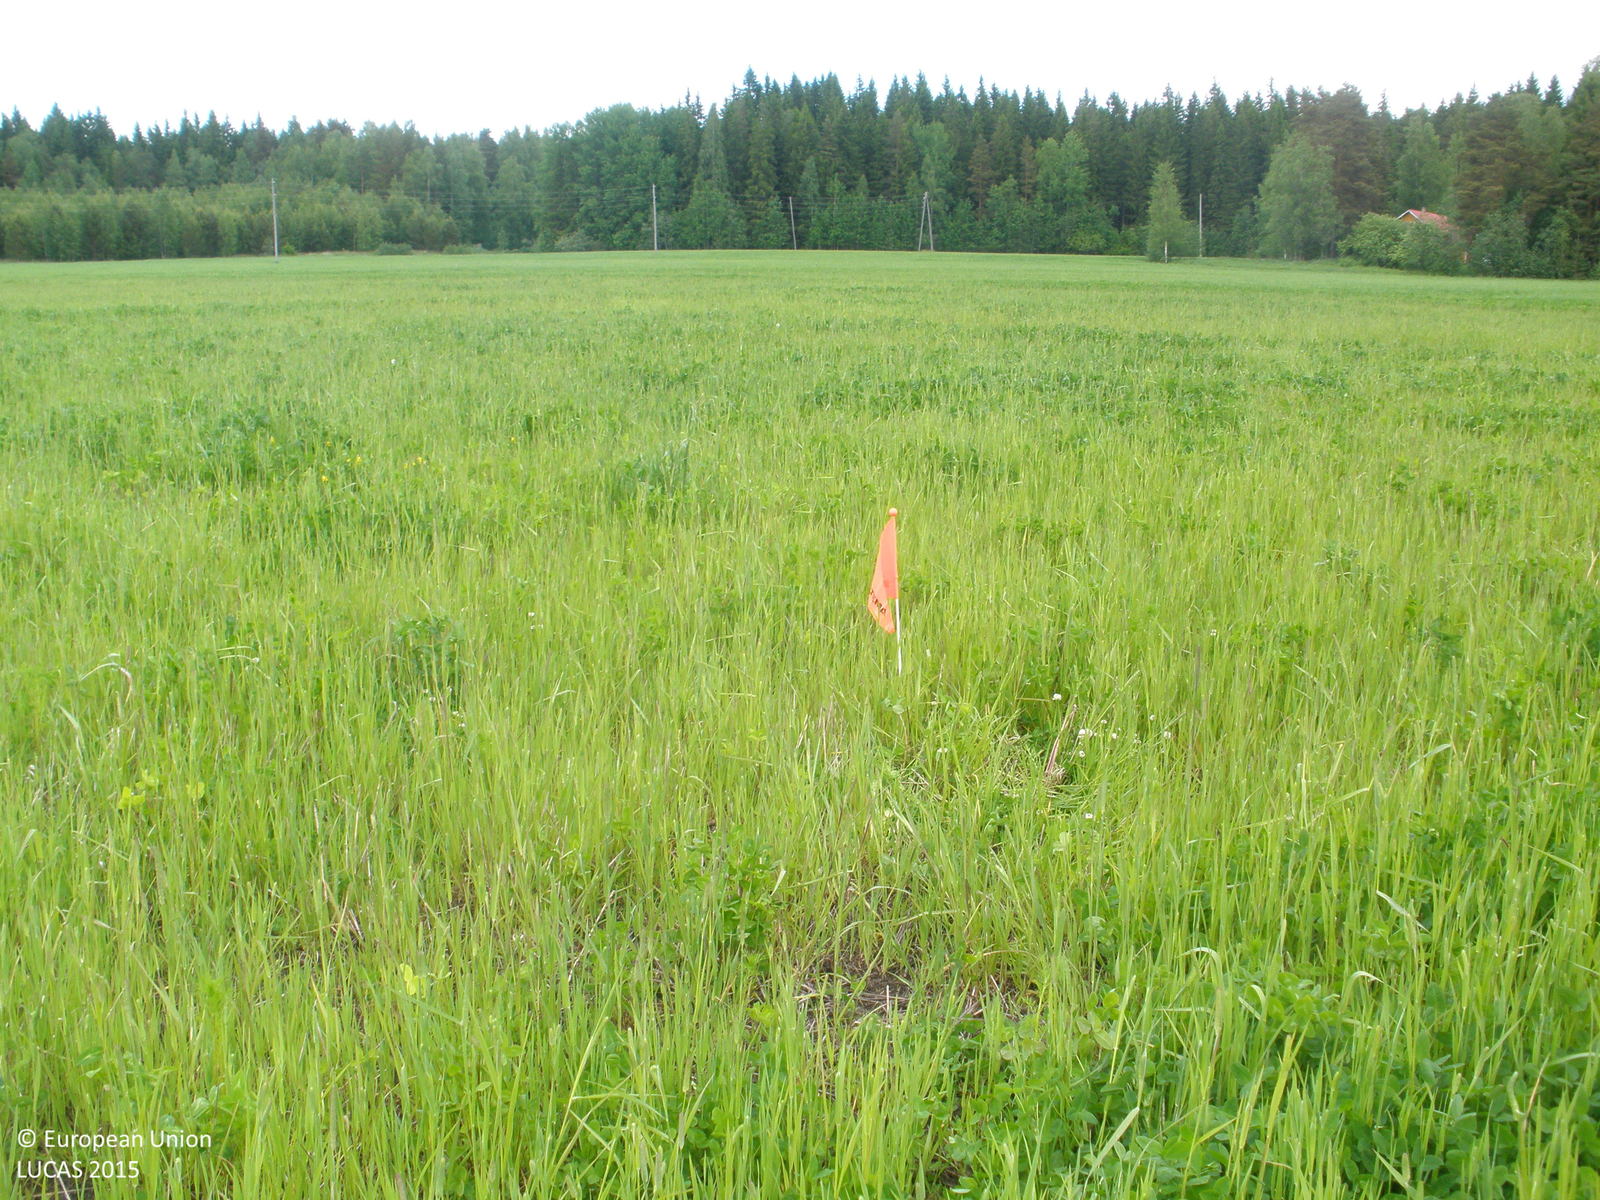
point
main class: Cropland
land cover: Other leguminous and mixtures for fodder
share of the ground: > 75 %
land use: Agriculture (excluding fallow land and kitchen gardens)
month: June
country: FI
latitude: 61.0671
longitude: 23.2908
